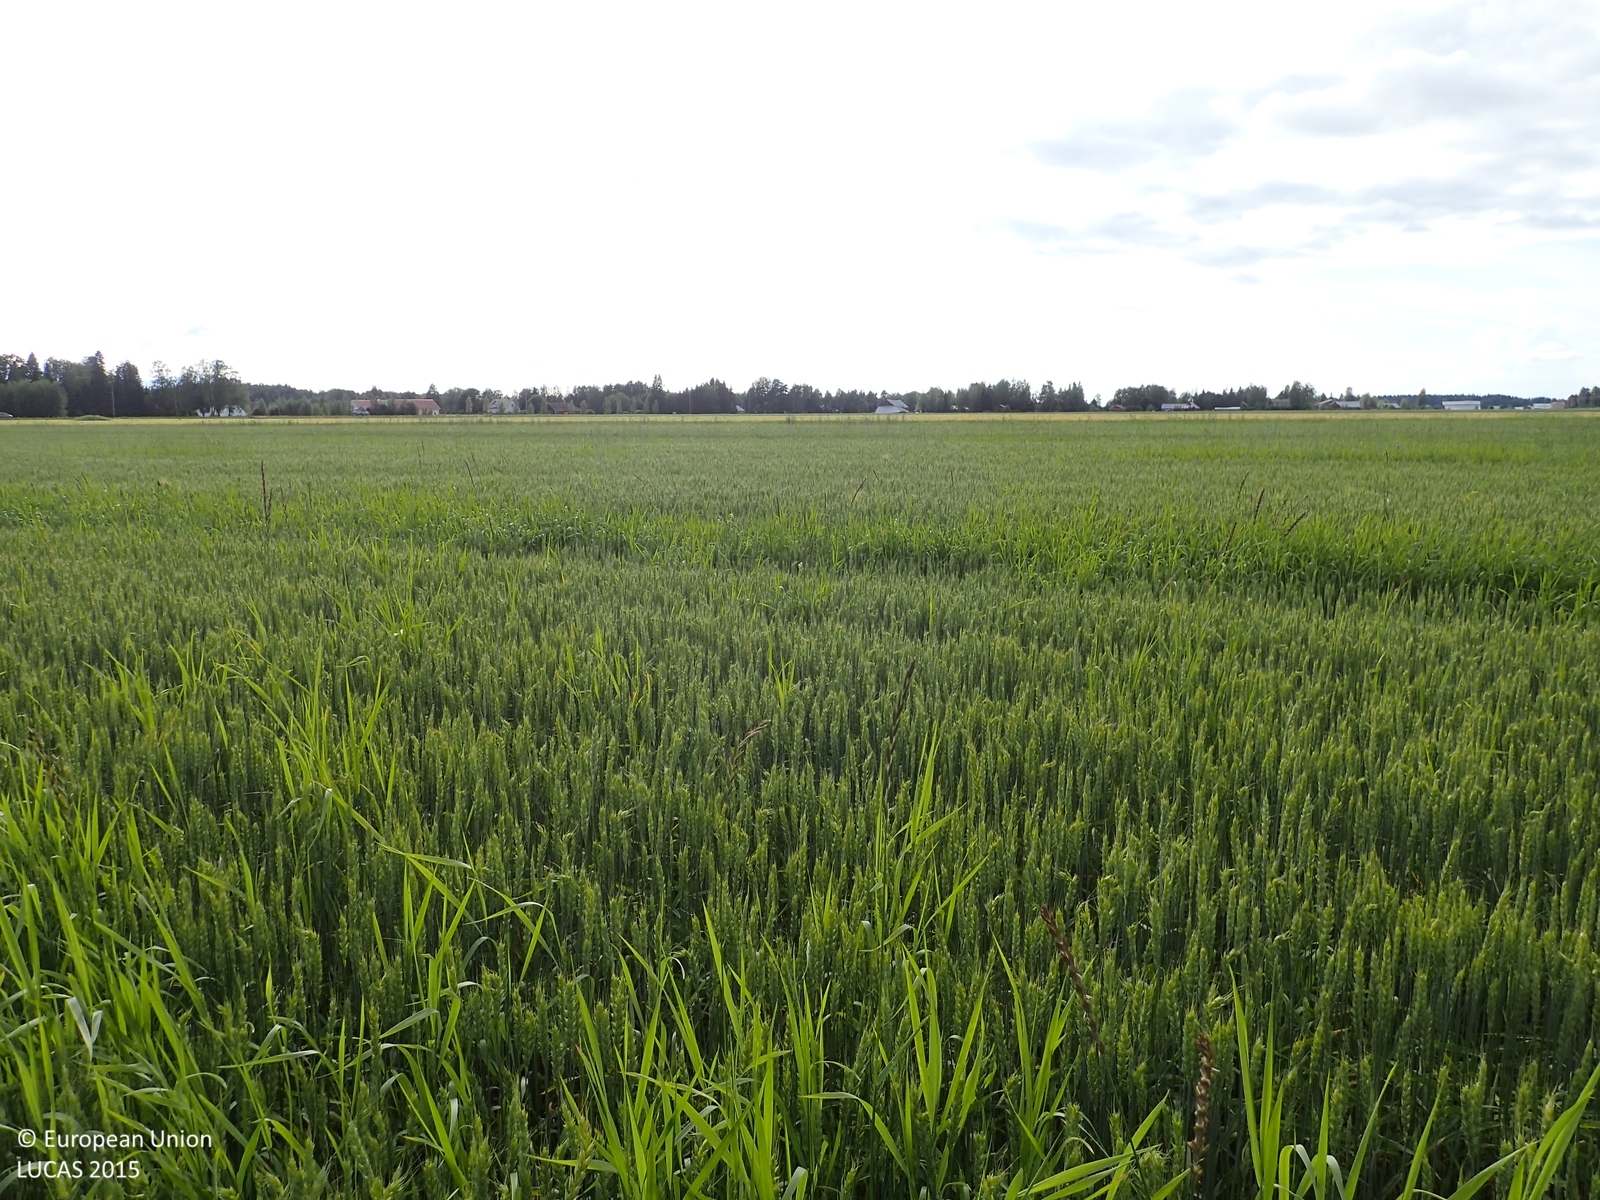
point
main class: Cropland
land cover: Common wheat
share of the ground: > 75 %
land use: Agriculture (excluding fallow land and kitchen gardens)
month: July
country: FI
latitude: 62.9909
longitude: 21.9863
